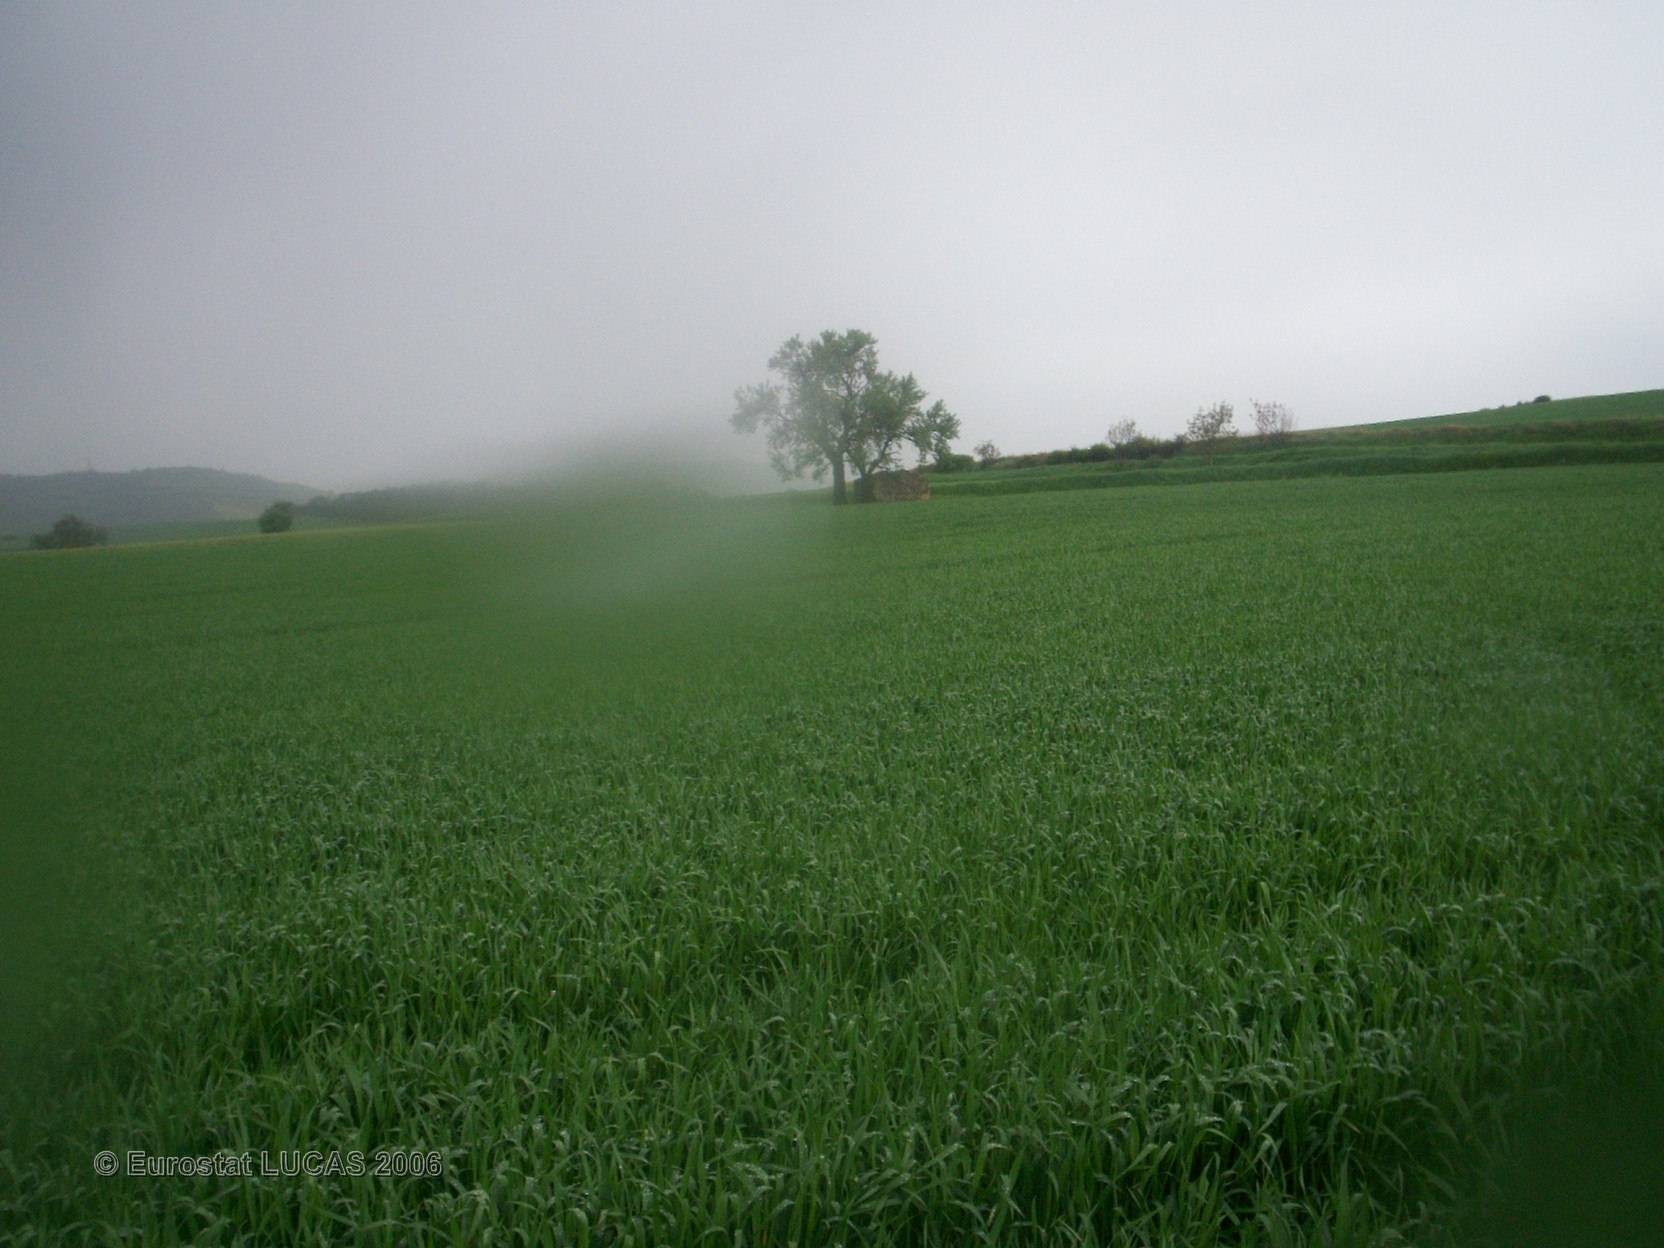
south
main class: Cropland
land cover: Common wheat
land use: Agriculture (excluding fallow land and kitchen gardens)
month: May
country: FR
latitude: 45.6050
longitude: 3.1152
